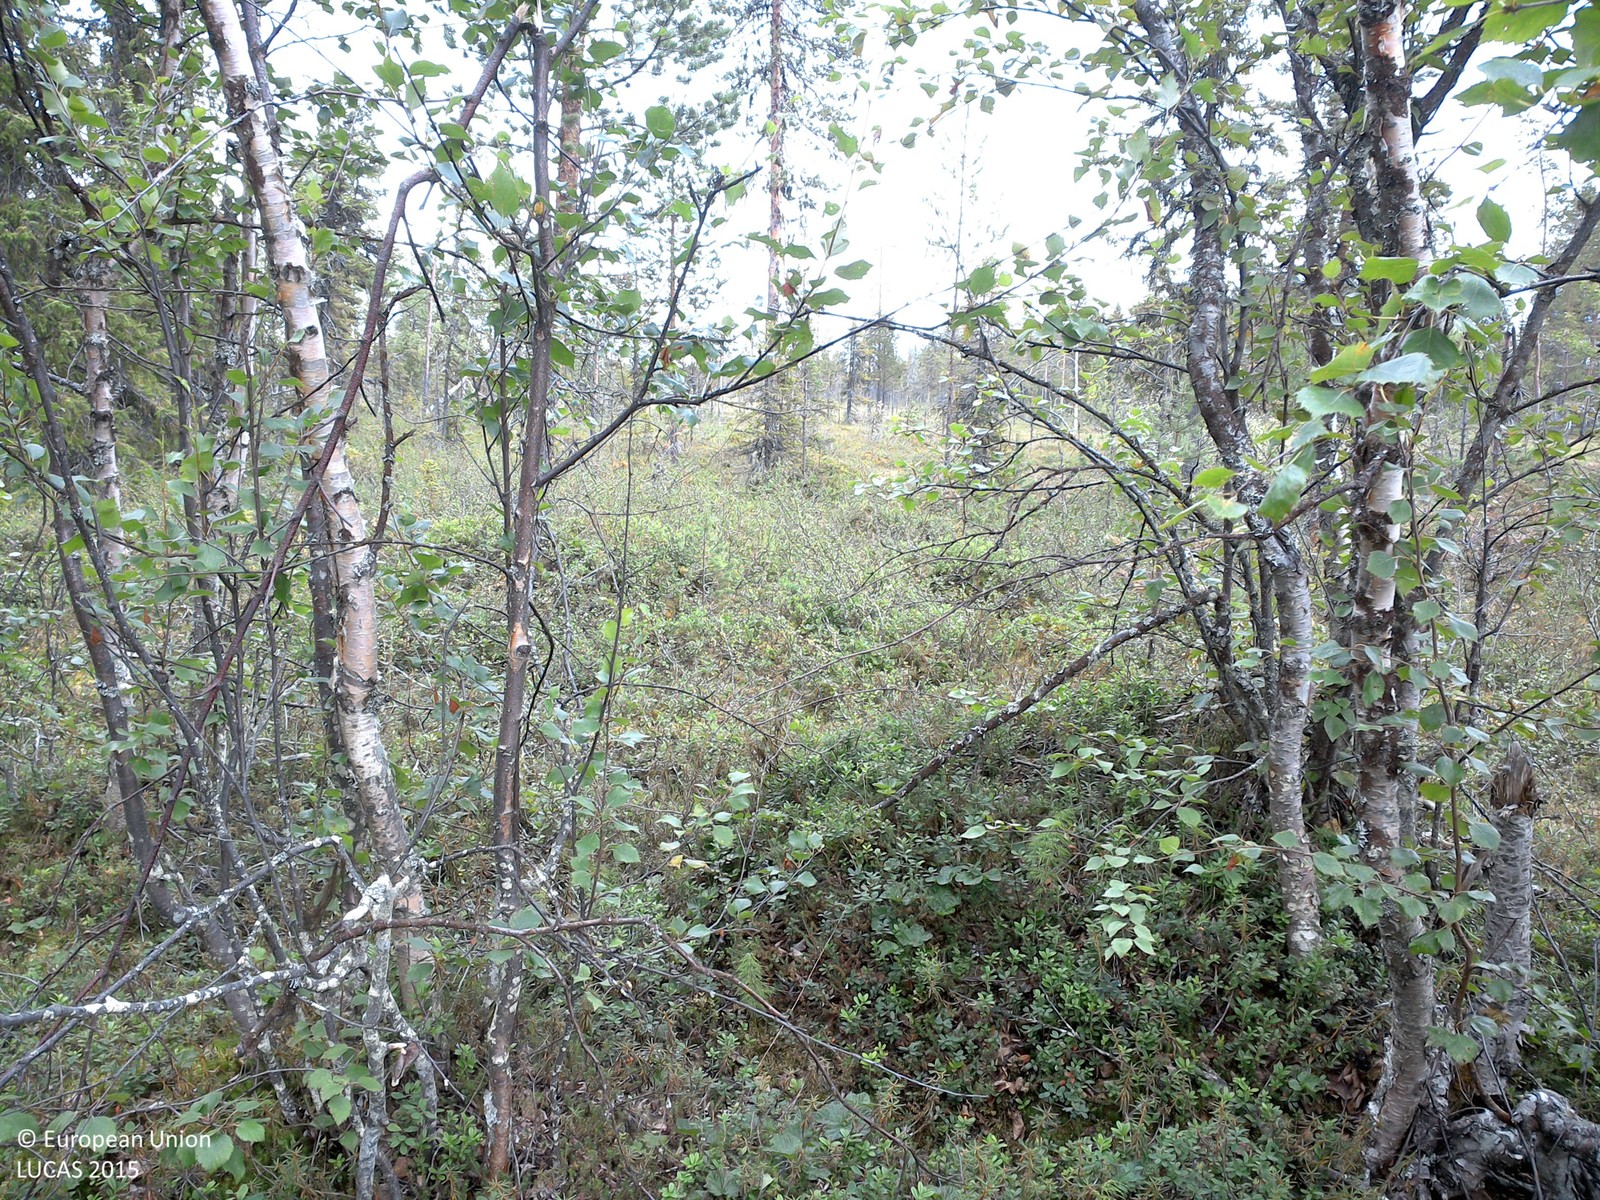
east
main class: Woodland
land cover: Pine dominated mixed woodland
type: boreal forest
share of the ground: 25 - 50 %
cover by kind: shrubs 60 %, coniferous forest trees 15 %, lichens and mosses 15 %, broadleaved forest trees 10 %
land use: Forestry
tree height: > 5 m
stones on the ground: < 10 %
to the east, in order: Pine dominated mixed woodland; Pine dominated coniferous woodland; Pine dominated mixed woodland; Pine dominated coniferous woodland; Peatbogs
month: August
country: SE
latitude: 67.4762
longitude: 21.5296
